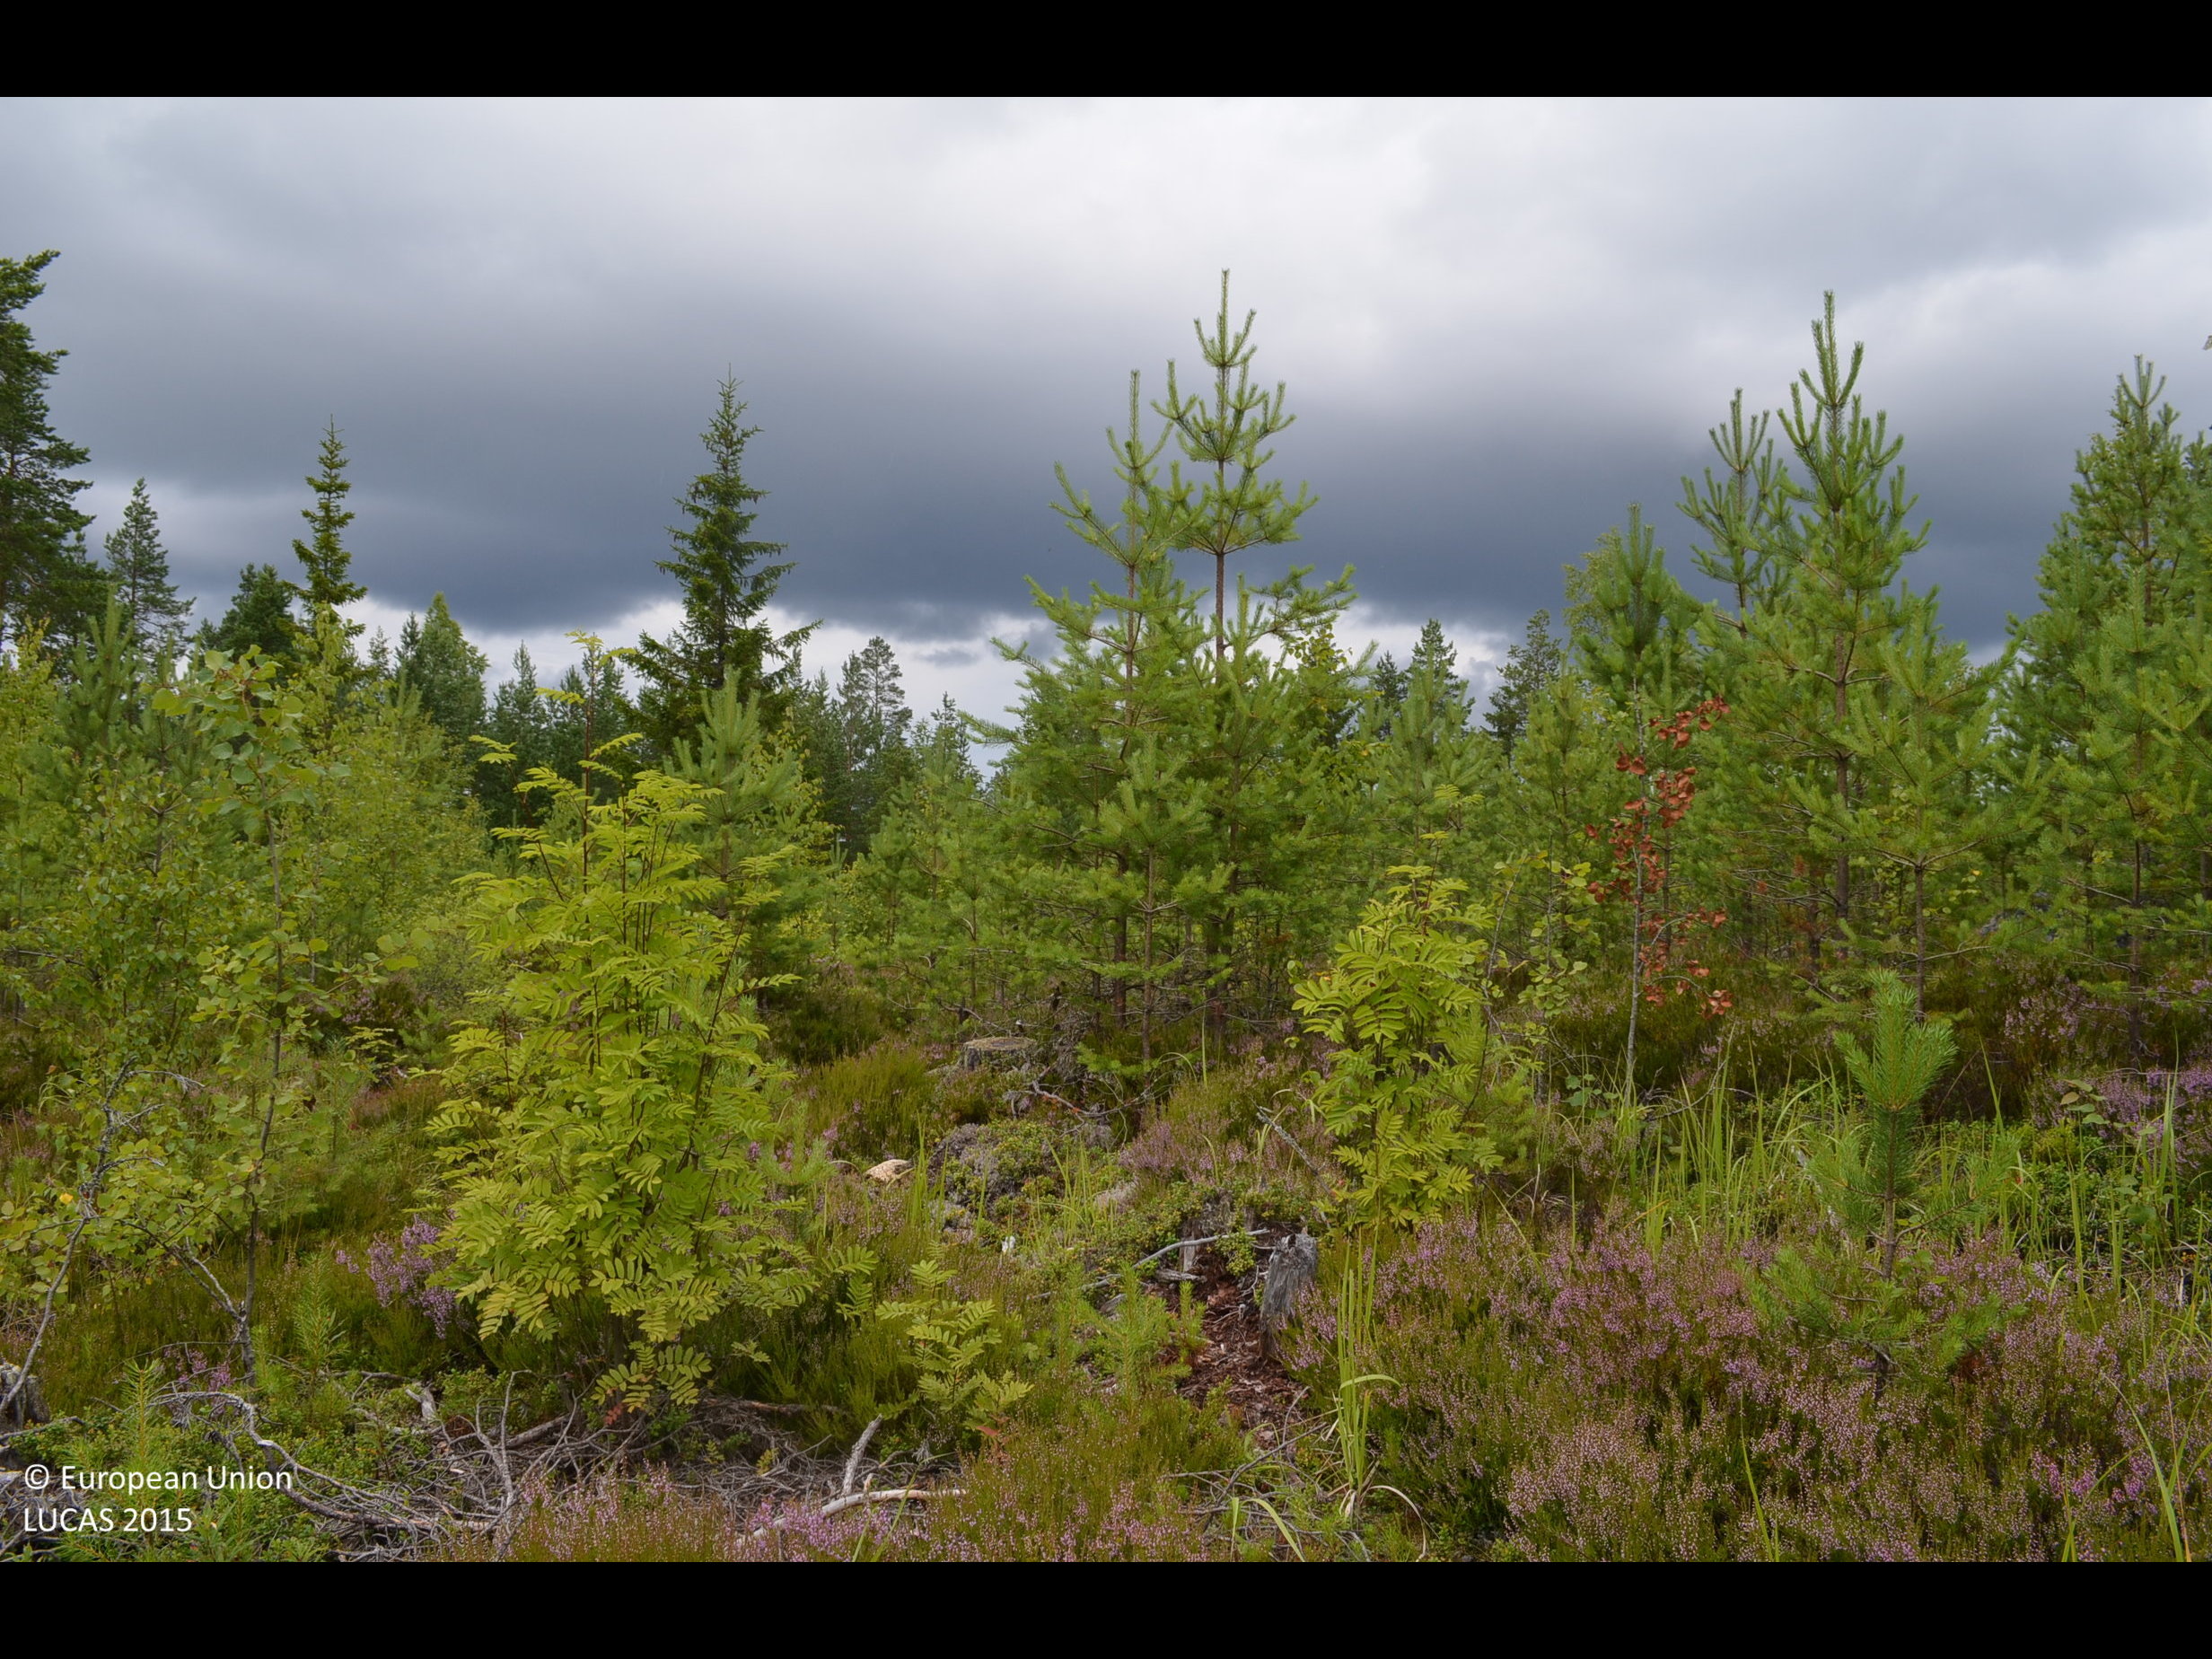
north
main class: Woodland
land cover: Pine dominated mixed woodland
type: boreal forest
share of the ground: 50 - 75 %
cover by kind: coniferous forest trees 35 %, shrubs 35 %, broadleaved forest trees 25 %, herbaceous plants 5 %
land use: Forestry
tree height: < 5 m
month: July
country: FI
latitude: 61.9339
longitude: 24.2069
